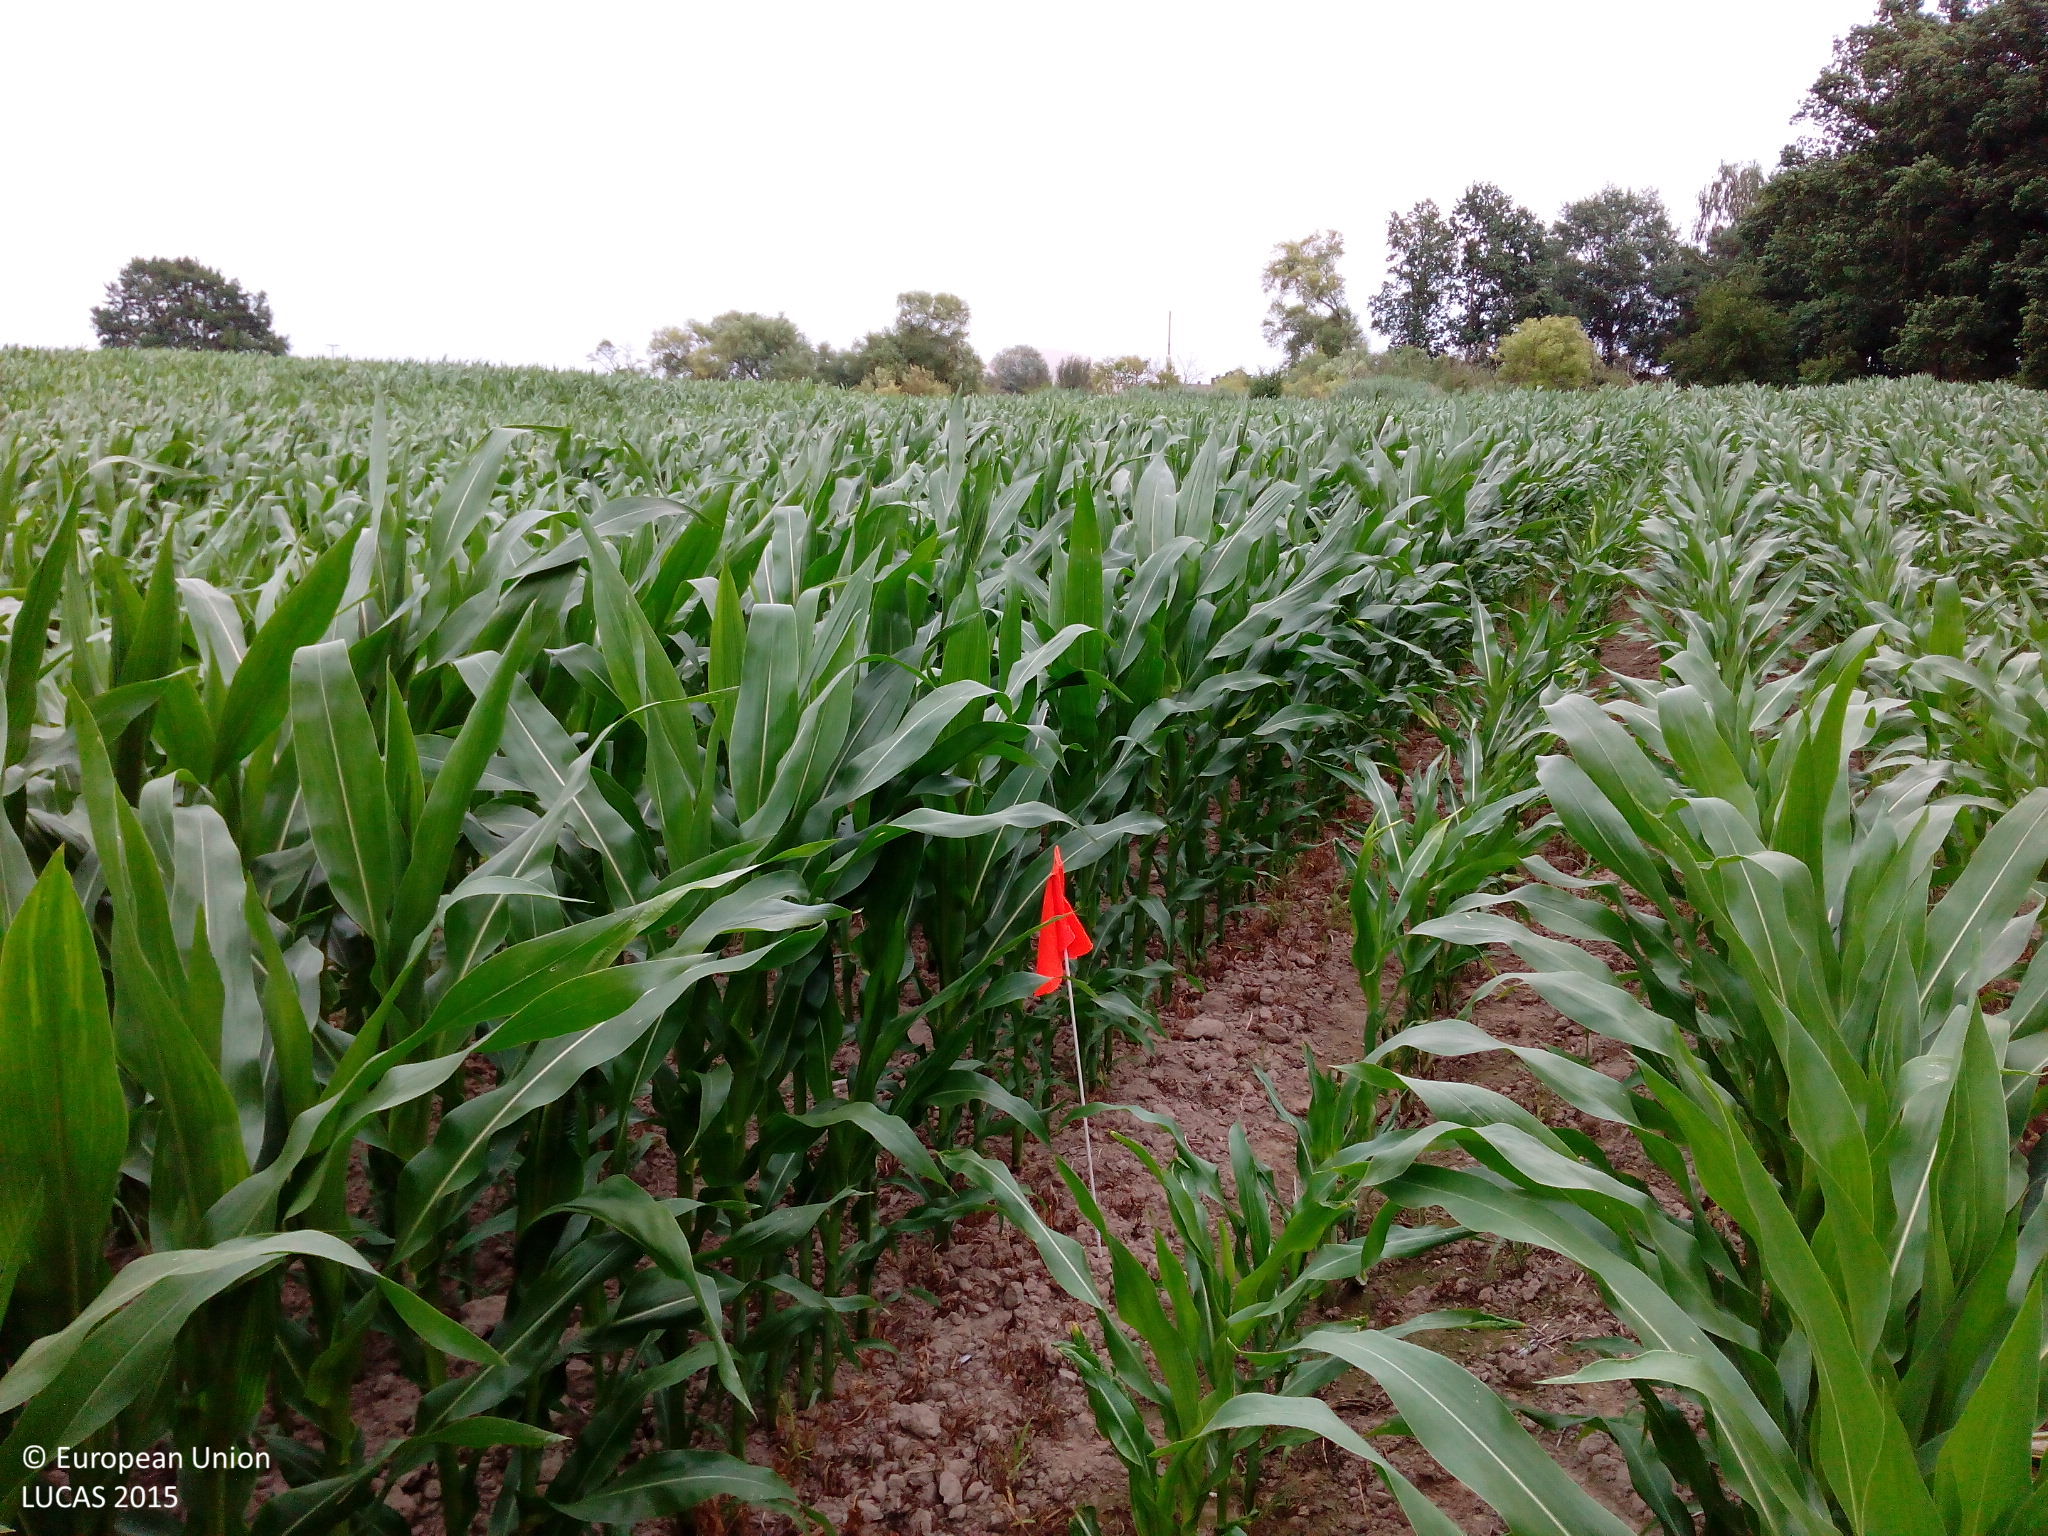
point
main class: Cropland
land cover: Maize
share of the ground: > 75 %
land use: Agriculture (excluding fallow land and kitchen gardens)
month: July
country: DE
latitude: 52.5212
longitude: 14.1423
